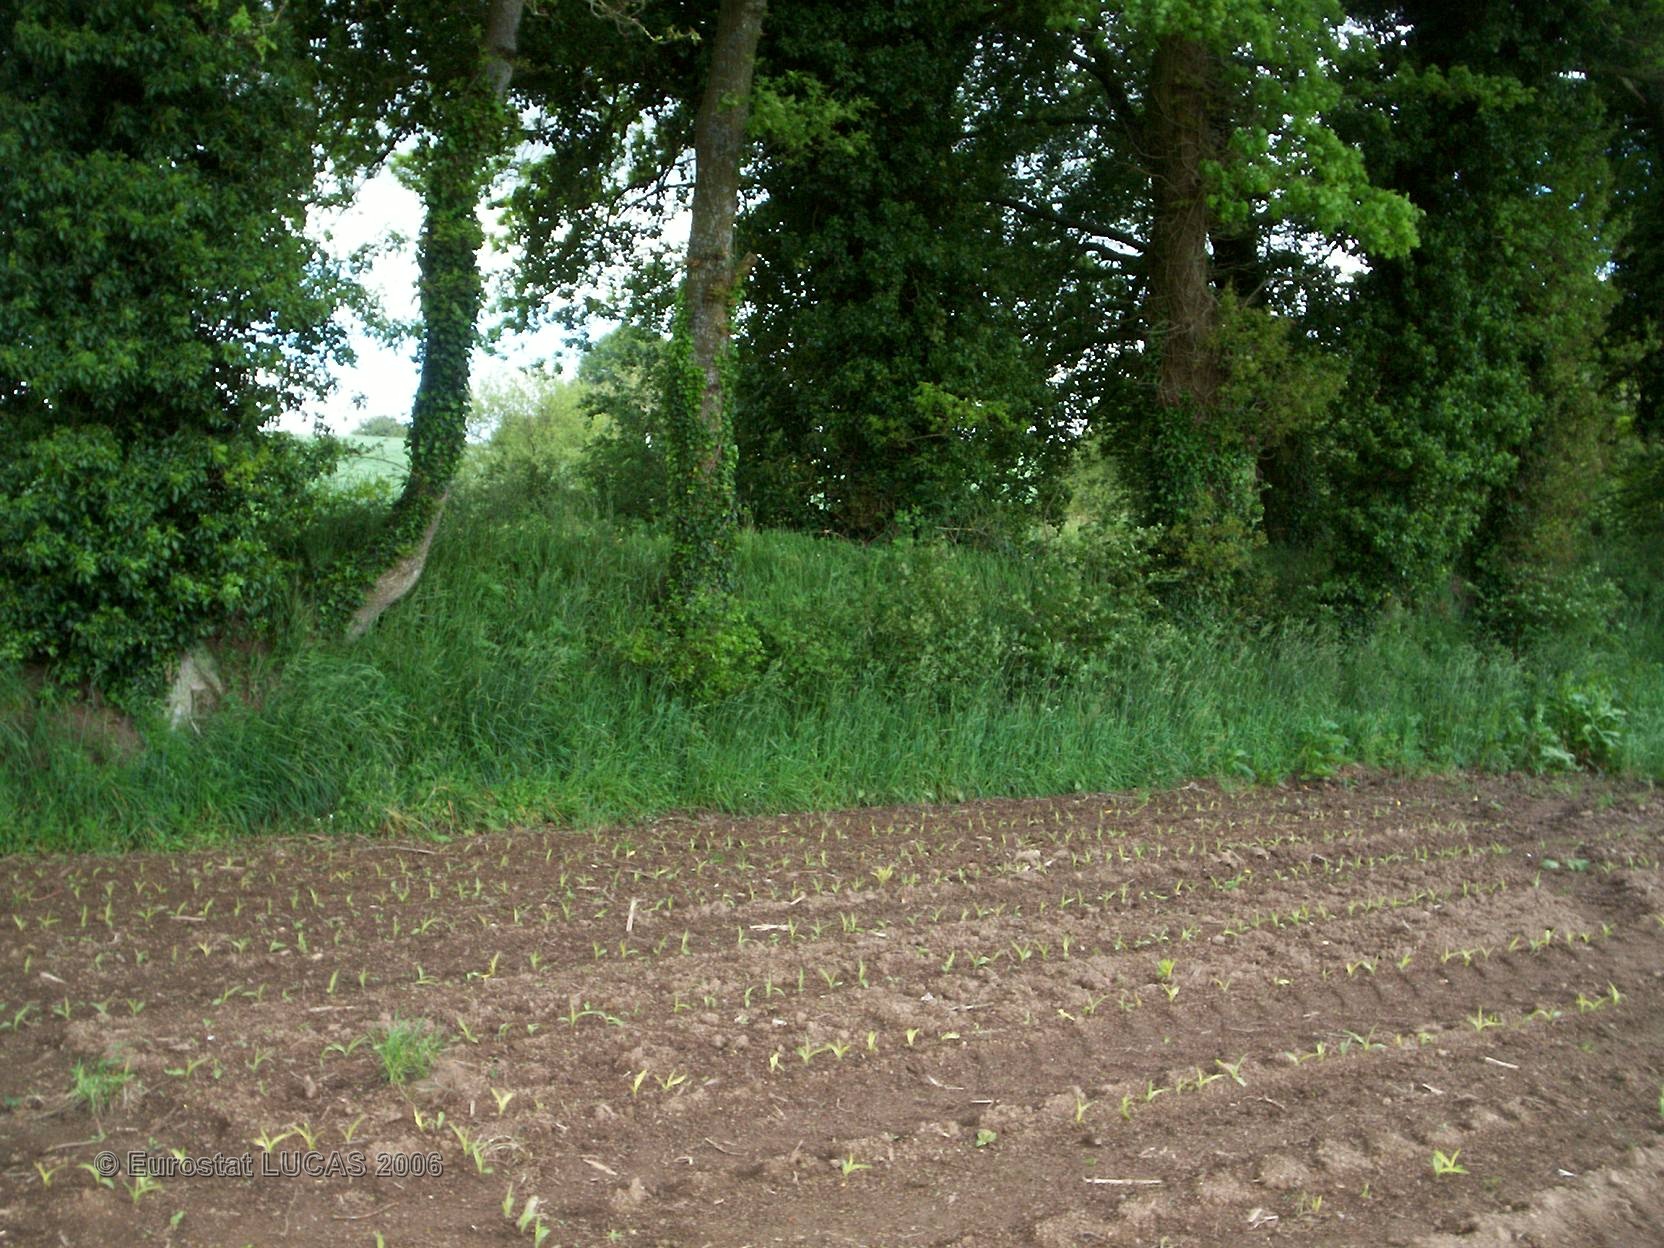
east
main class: Cropland
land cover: Maize
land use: Agriculture (excluding fallow land and kitchen gardens)
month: May
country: FR
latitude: 48.3948
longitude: -3.0220
